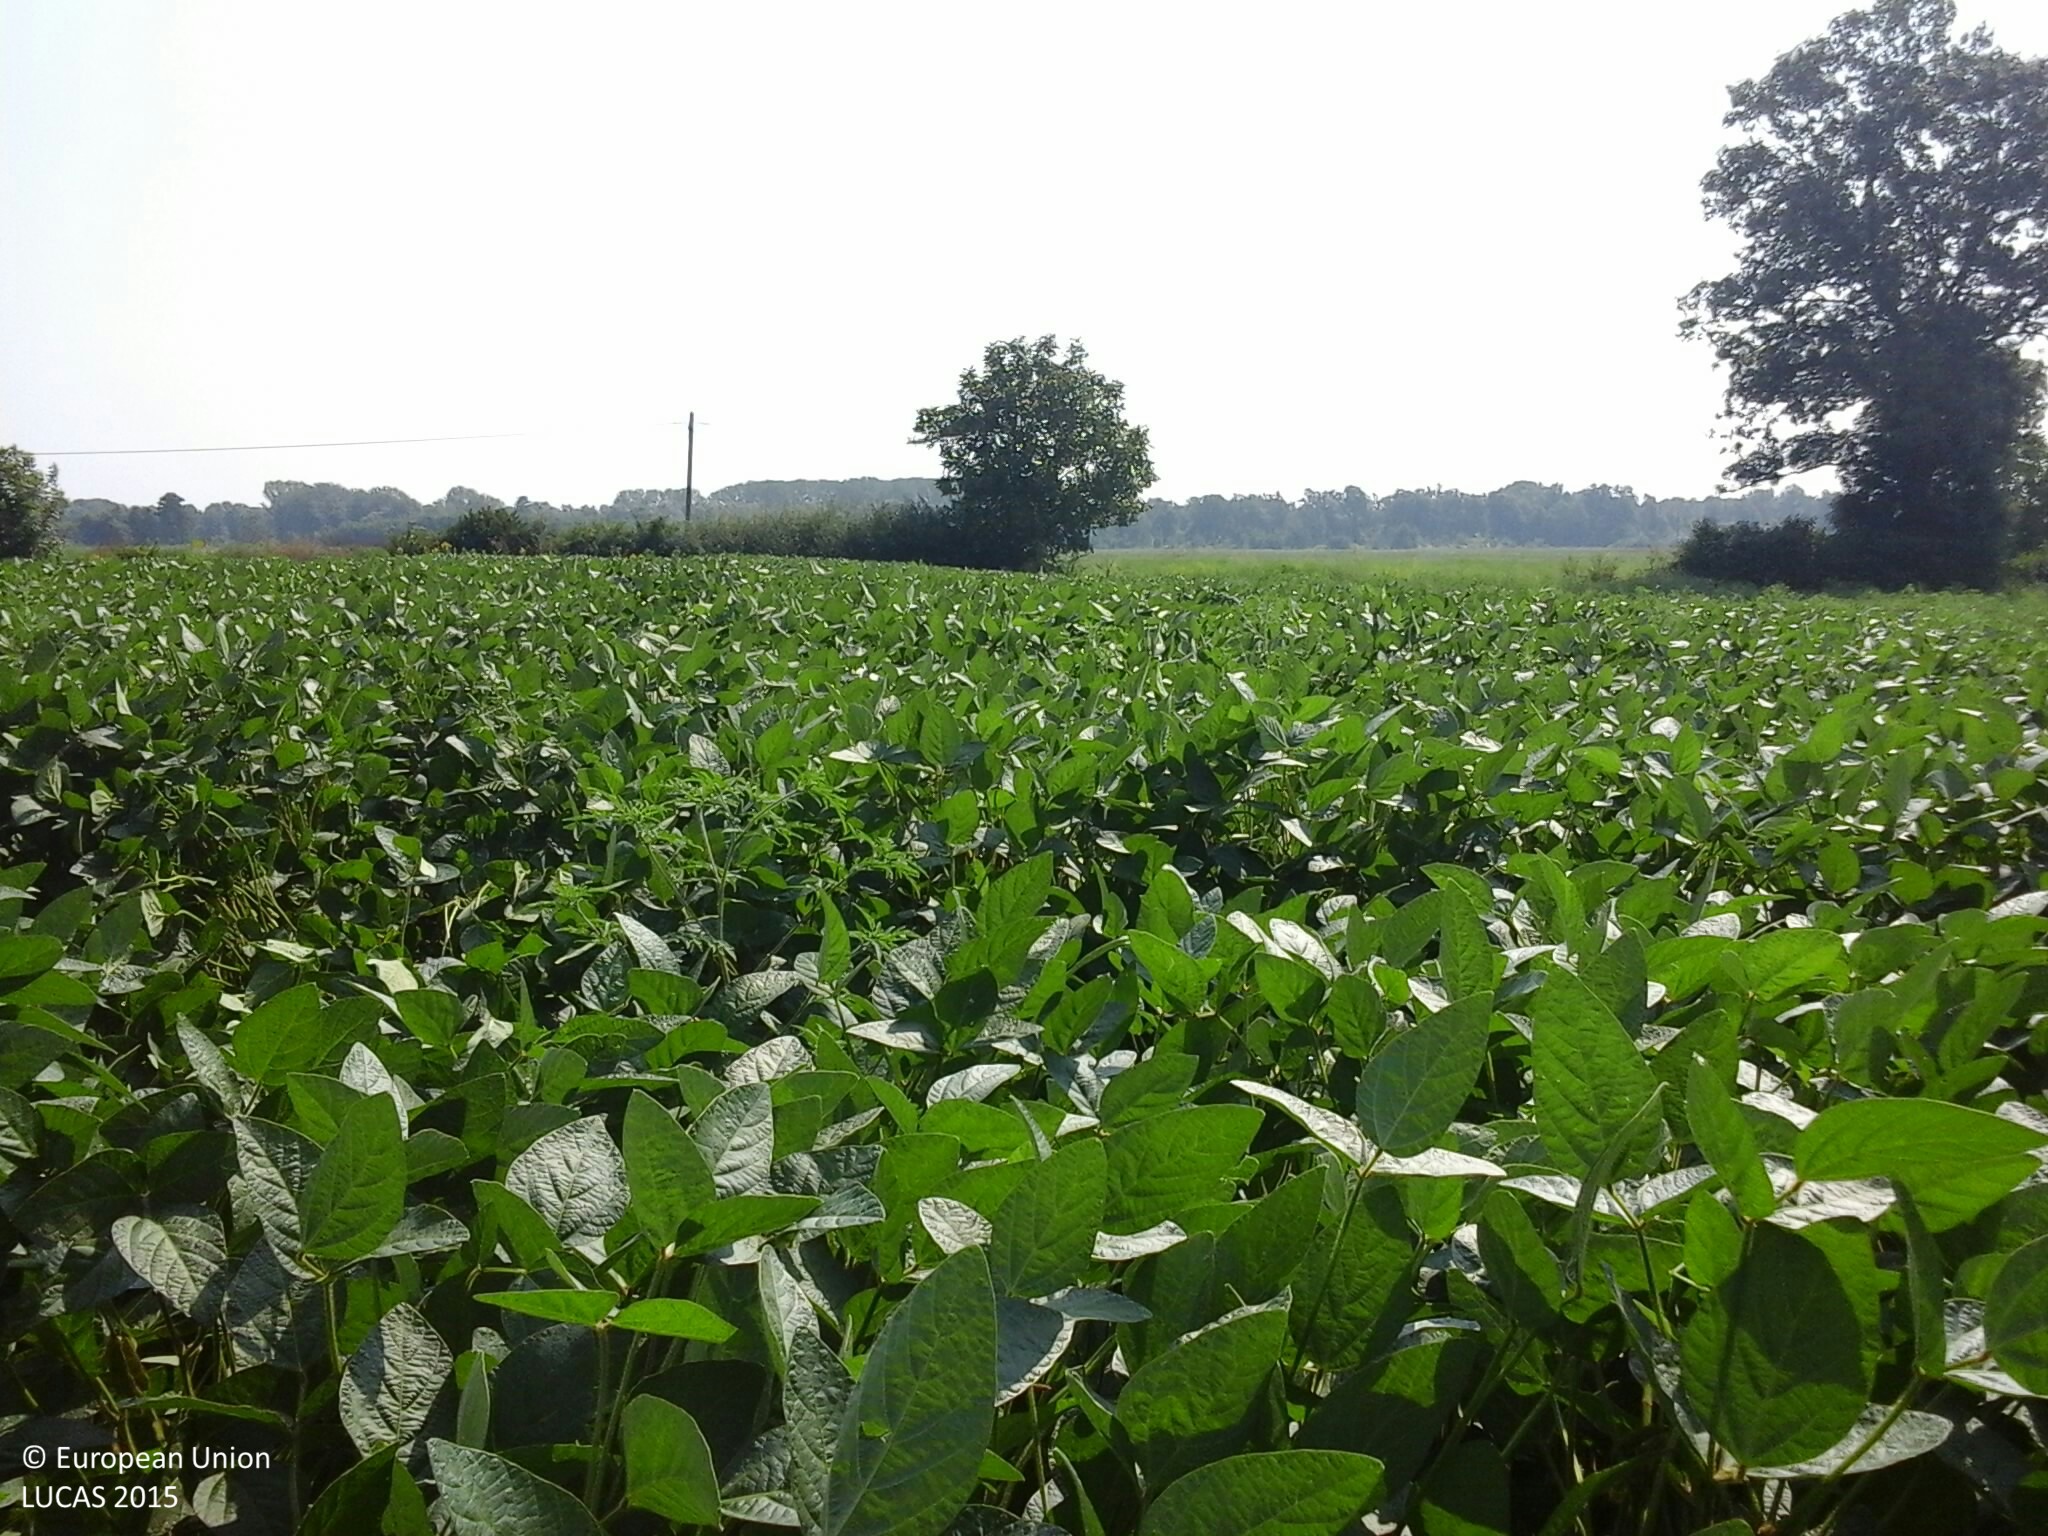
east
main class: Cropland
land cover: Soya
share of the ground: > 75 %
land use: Agriculture (excluding fallow land and kitchen gardens)
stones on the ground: < 10 %
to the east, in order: Soya; Abandoned hedges; Grass margins; Paved roads, cycling and walking lanes; Grass margins; Electric lines; Shruby margins; Soya; Spontaneously vegetated surfaces; Soya
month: August
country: HU
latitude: 45.7944
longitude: 18.0456
